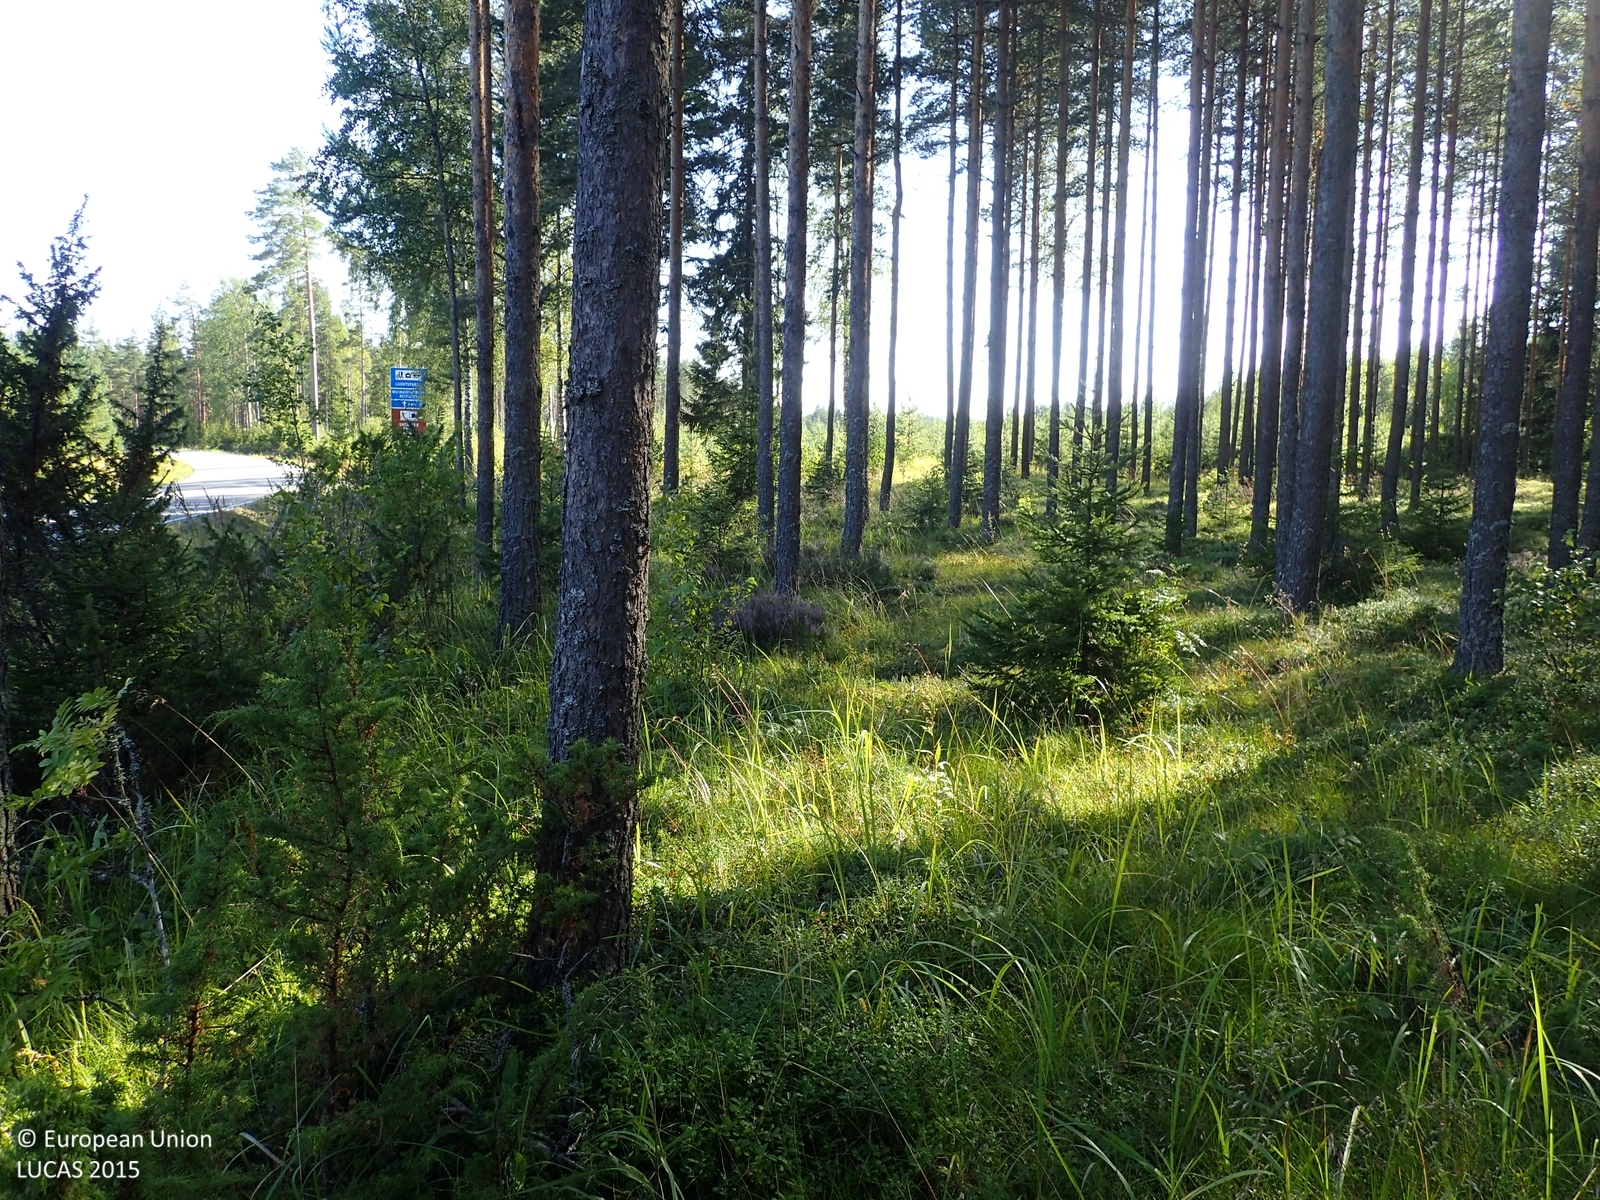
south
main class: Woodland
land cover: Pine dominated coniferous woodland
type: boreal forest
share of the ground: > 75 %
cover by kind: coniferous forest trees 75 %, shrubs 20 %, herbaceous plants 5 %
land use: Forestry
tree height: > 5 m
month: August
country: FI
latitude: 62.4384
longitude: 21.8065
